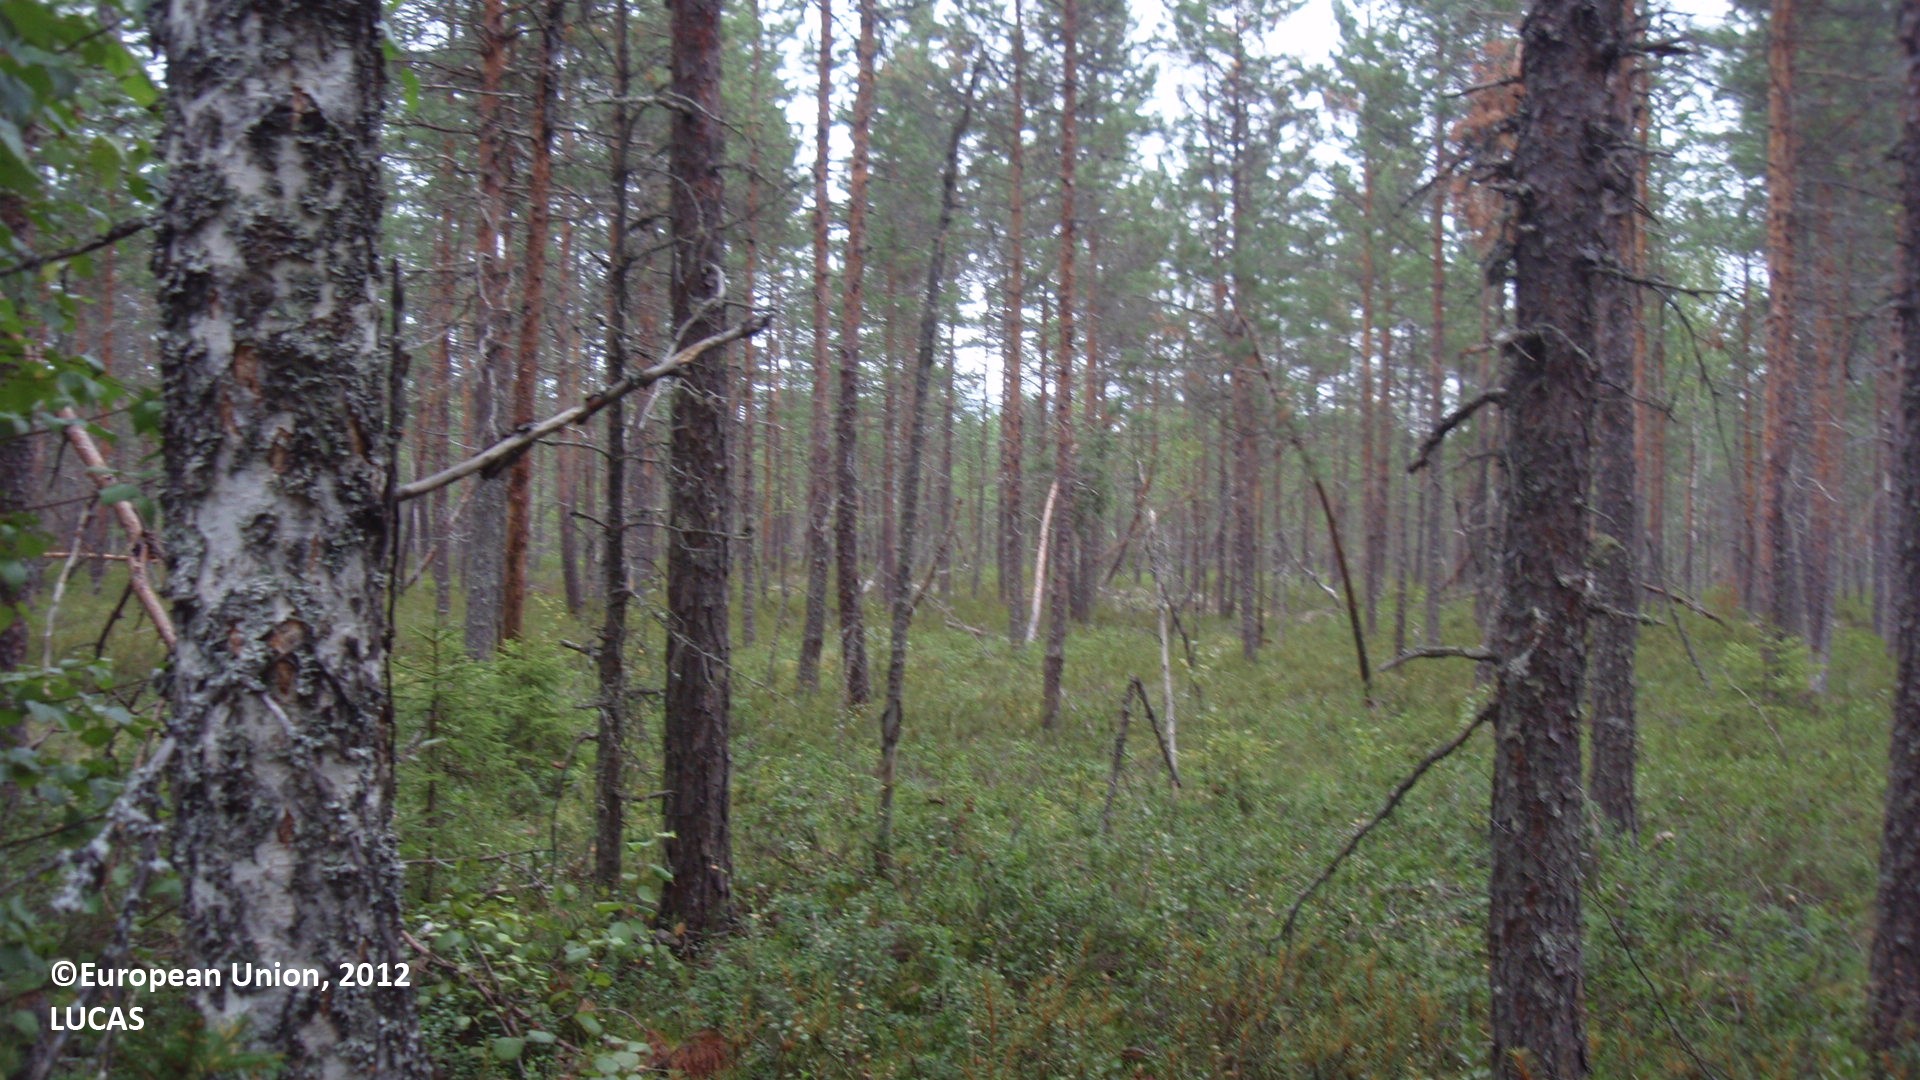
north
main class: Woodland
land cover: Pine dominated coniferous woodland
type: boreal forest
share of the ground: 50 - 75 %
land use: Forestry
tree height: > 5 m
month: August
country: FI
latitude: 61.1939
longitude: 27.4242
